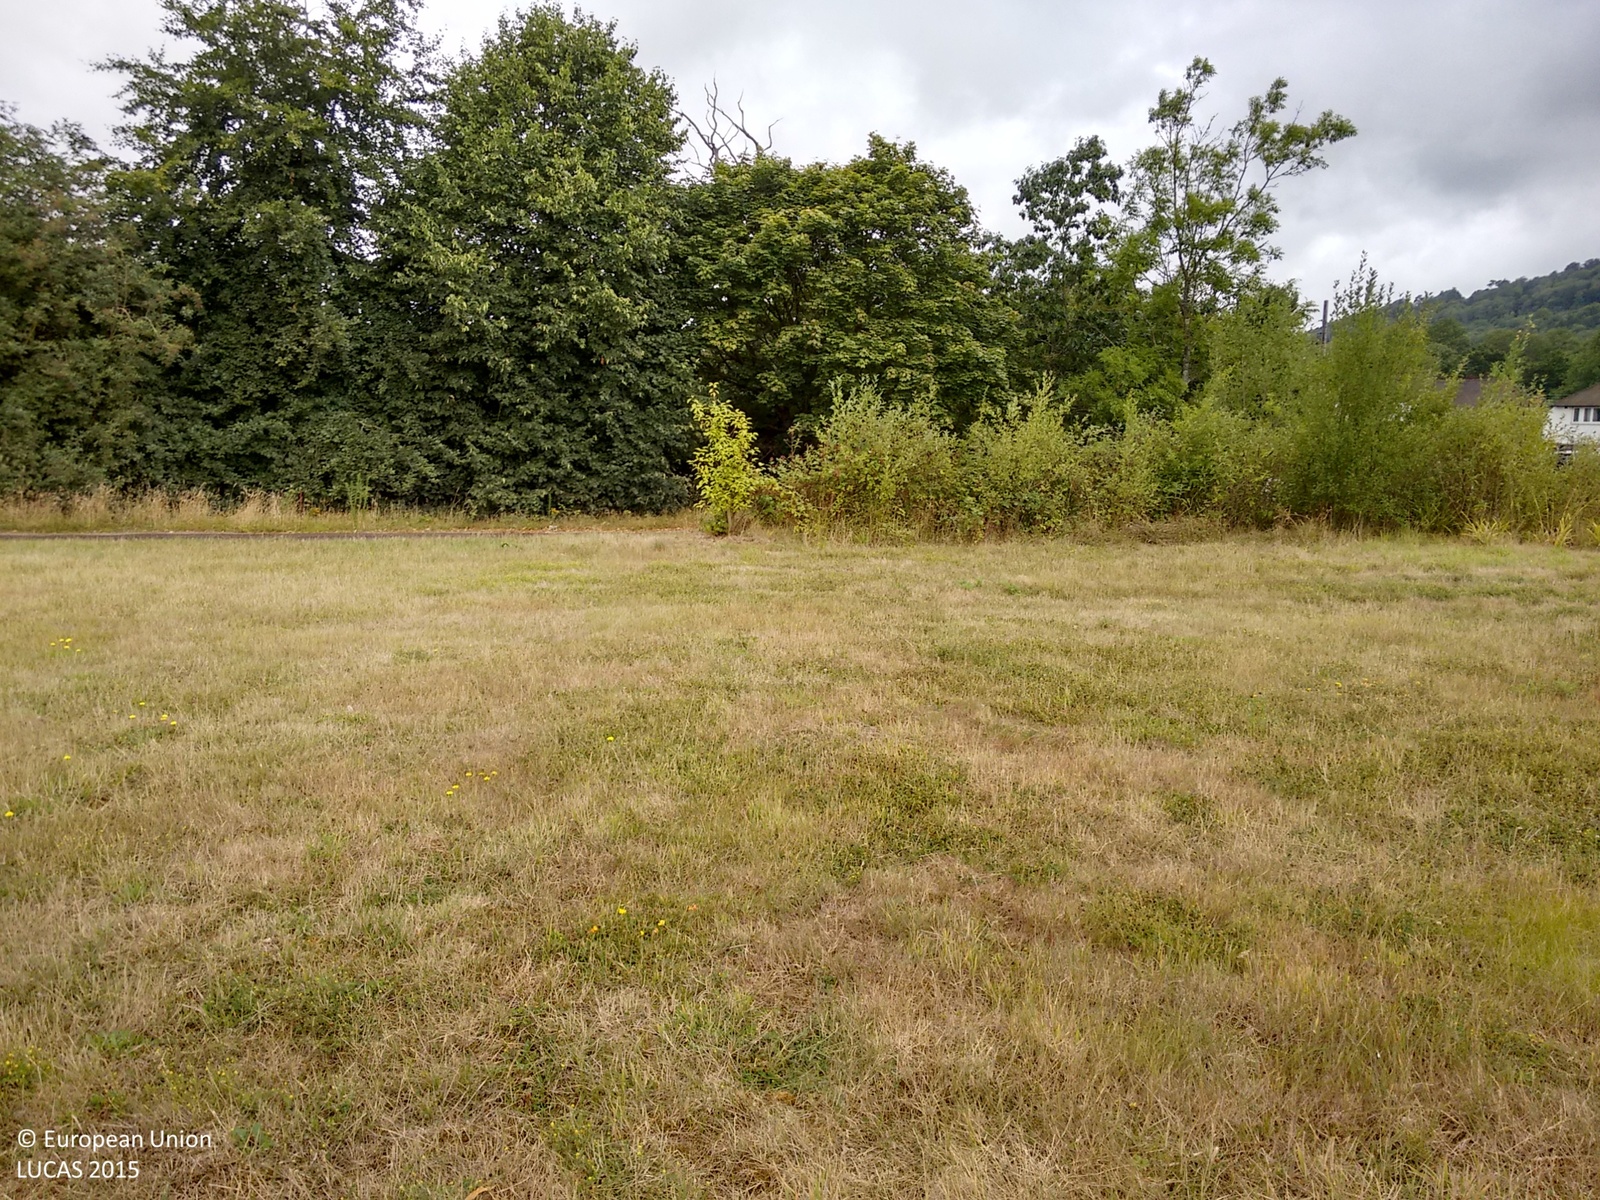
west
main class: Grassland
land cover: Grassland without tree/shrub cover
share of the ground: > 75 %
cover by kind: herbaceous plants 100 %
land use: Semi-natural and natural areas not in use
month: August
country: GB
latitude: 51.2413
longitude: -0.2778
